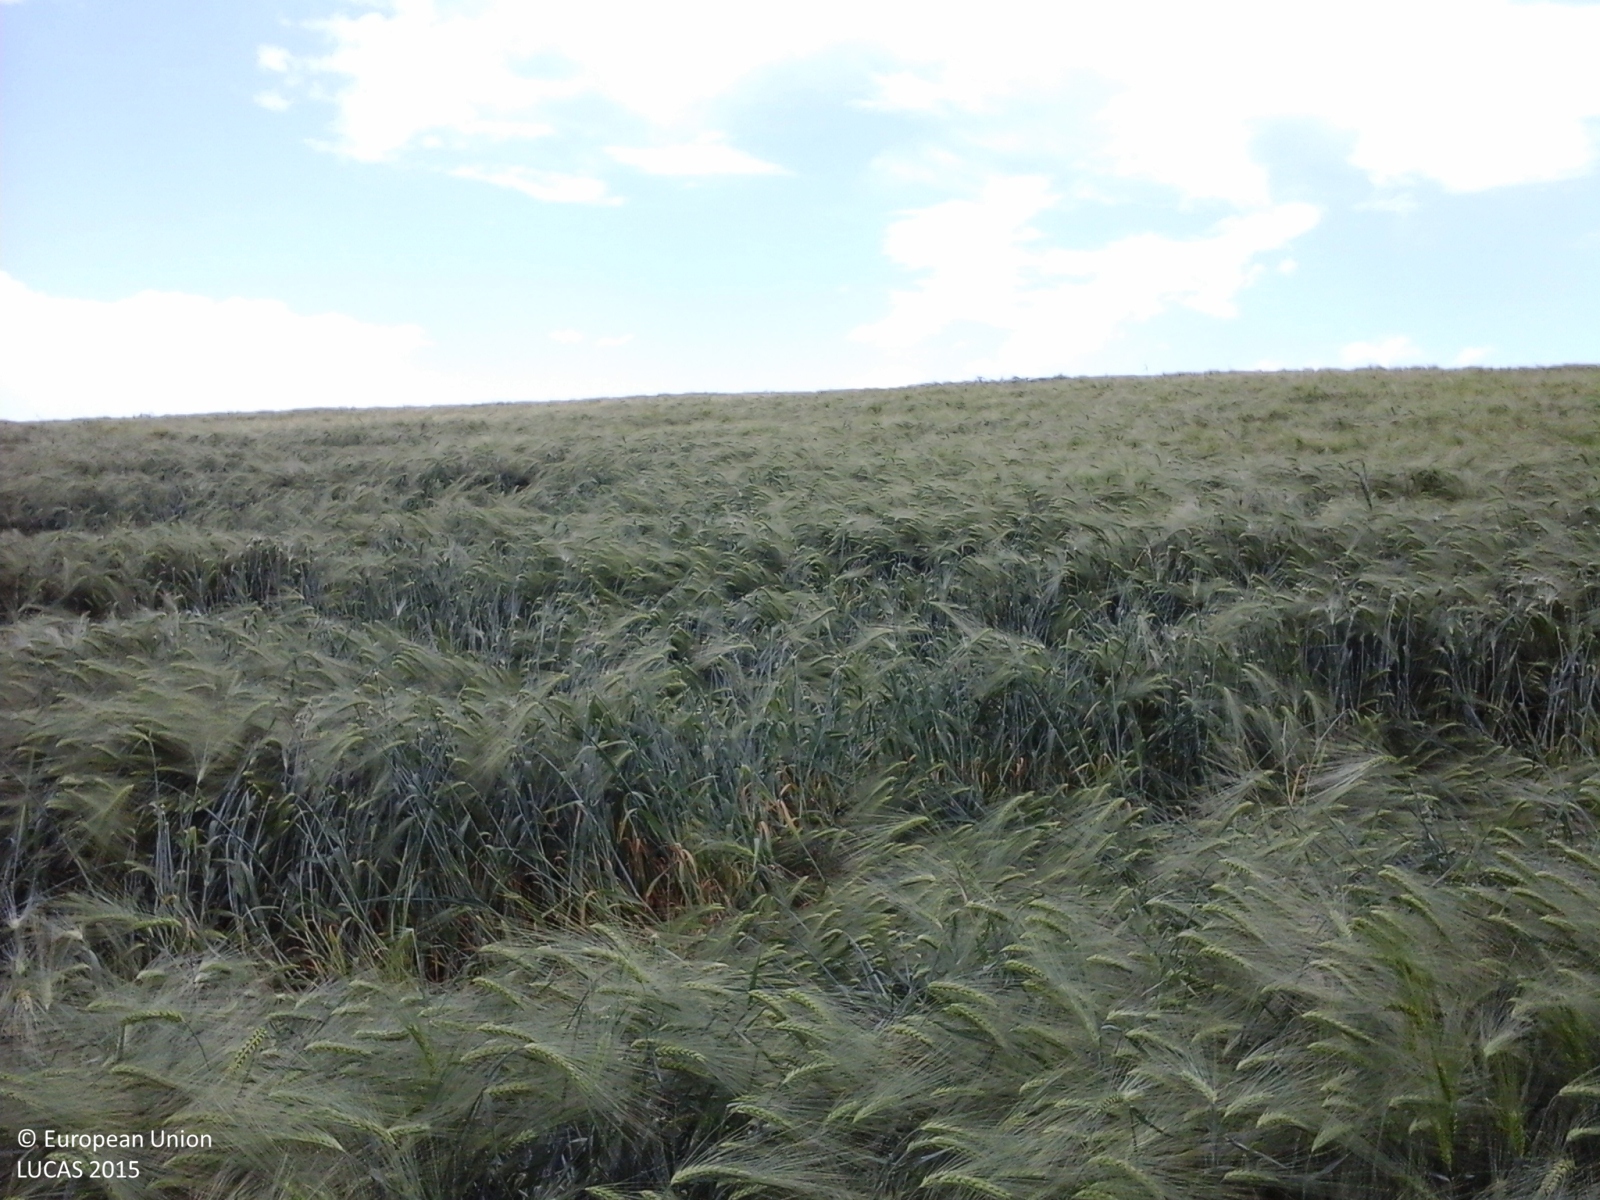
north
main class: Cropland
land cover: Barley
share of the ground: > 75 %
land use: Agriculture (excluding fallow land and kitchen gardens)
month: May
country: IT
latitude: 44.6189
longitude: 10.6665
